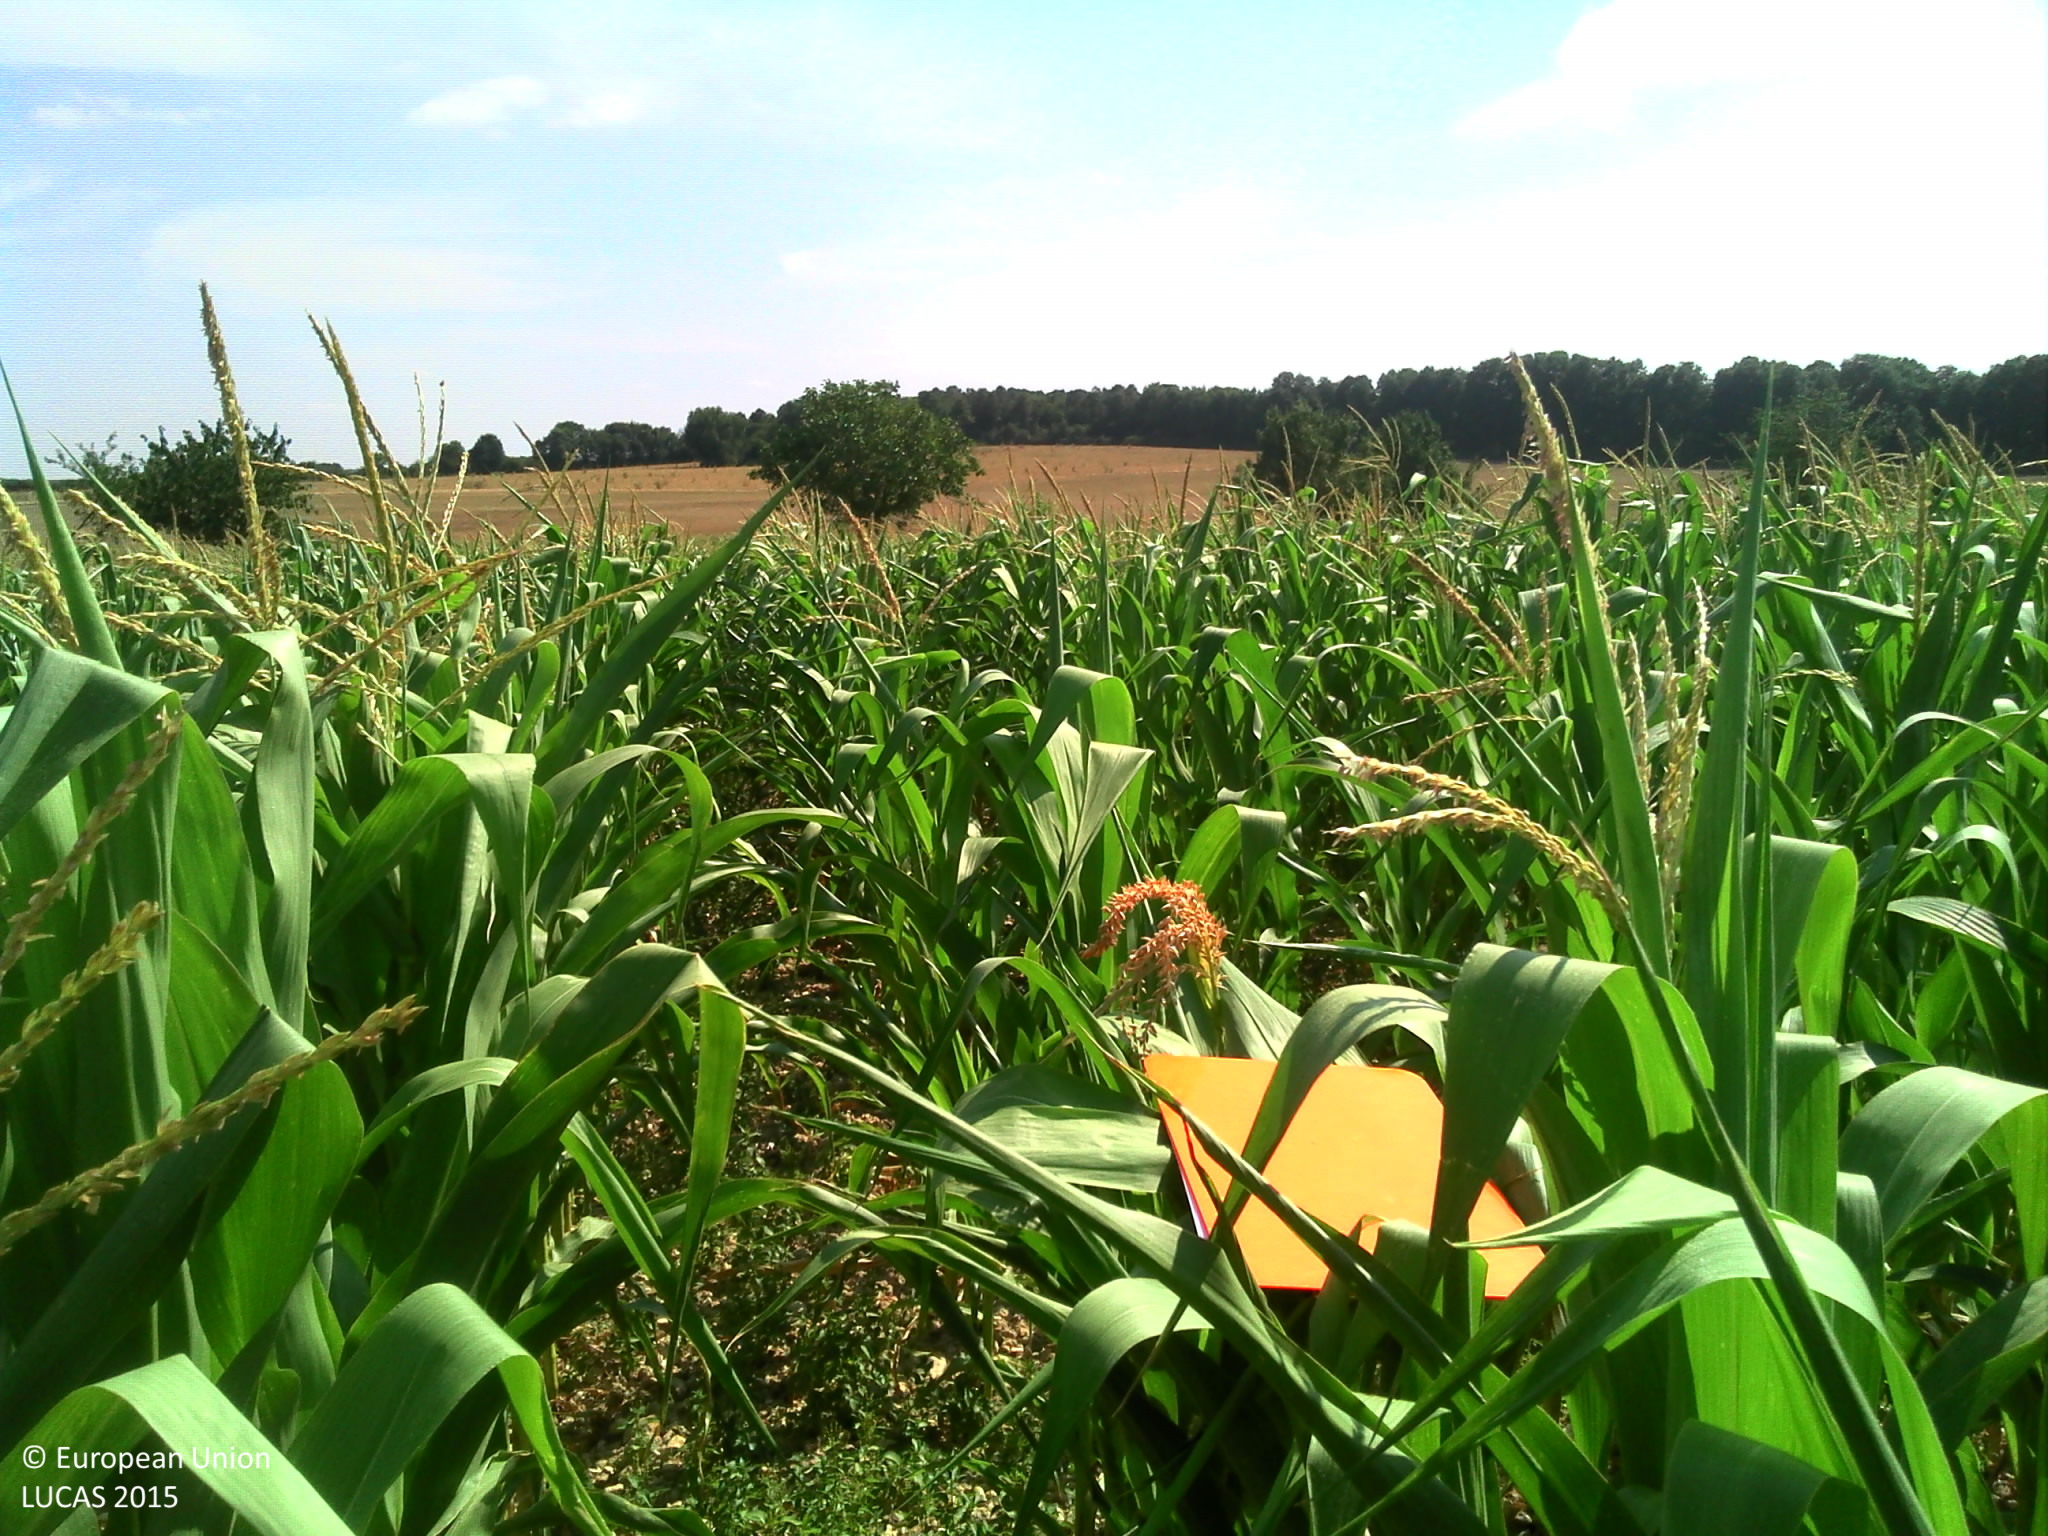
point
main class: Cropland
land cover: Maize
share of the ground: > 75 %
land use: Agriculture (excluding fallow land and kitchen gardens)
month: July
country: FR
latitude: 46.9505
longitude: 0.7989
